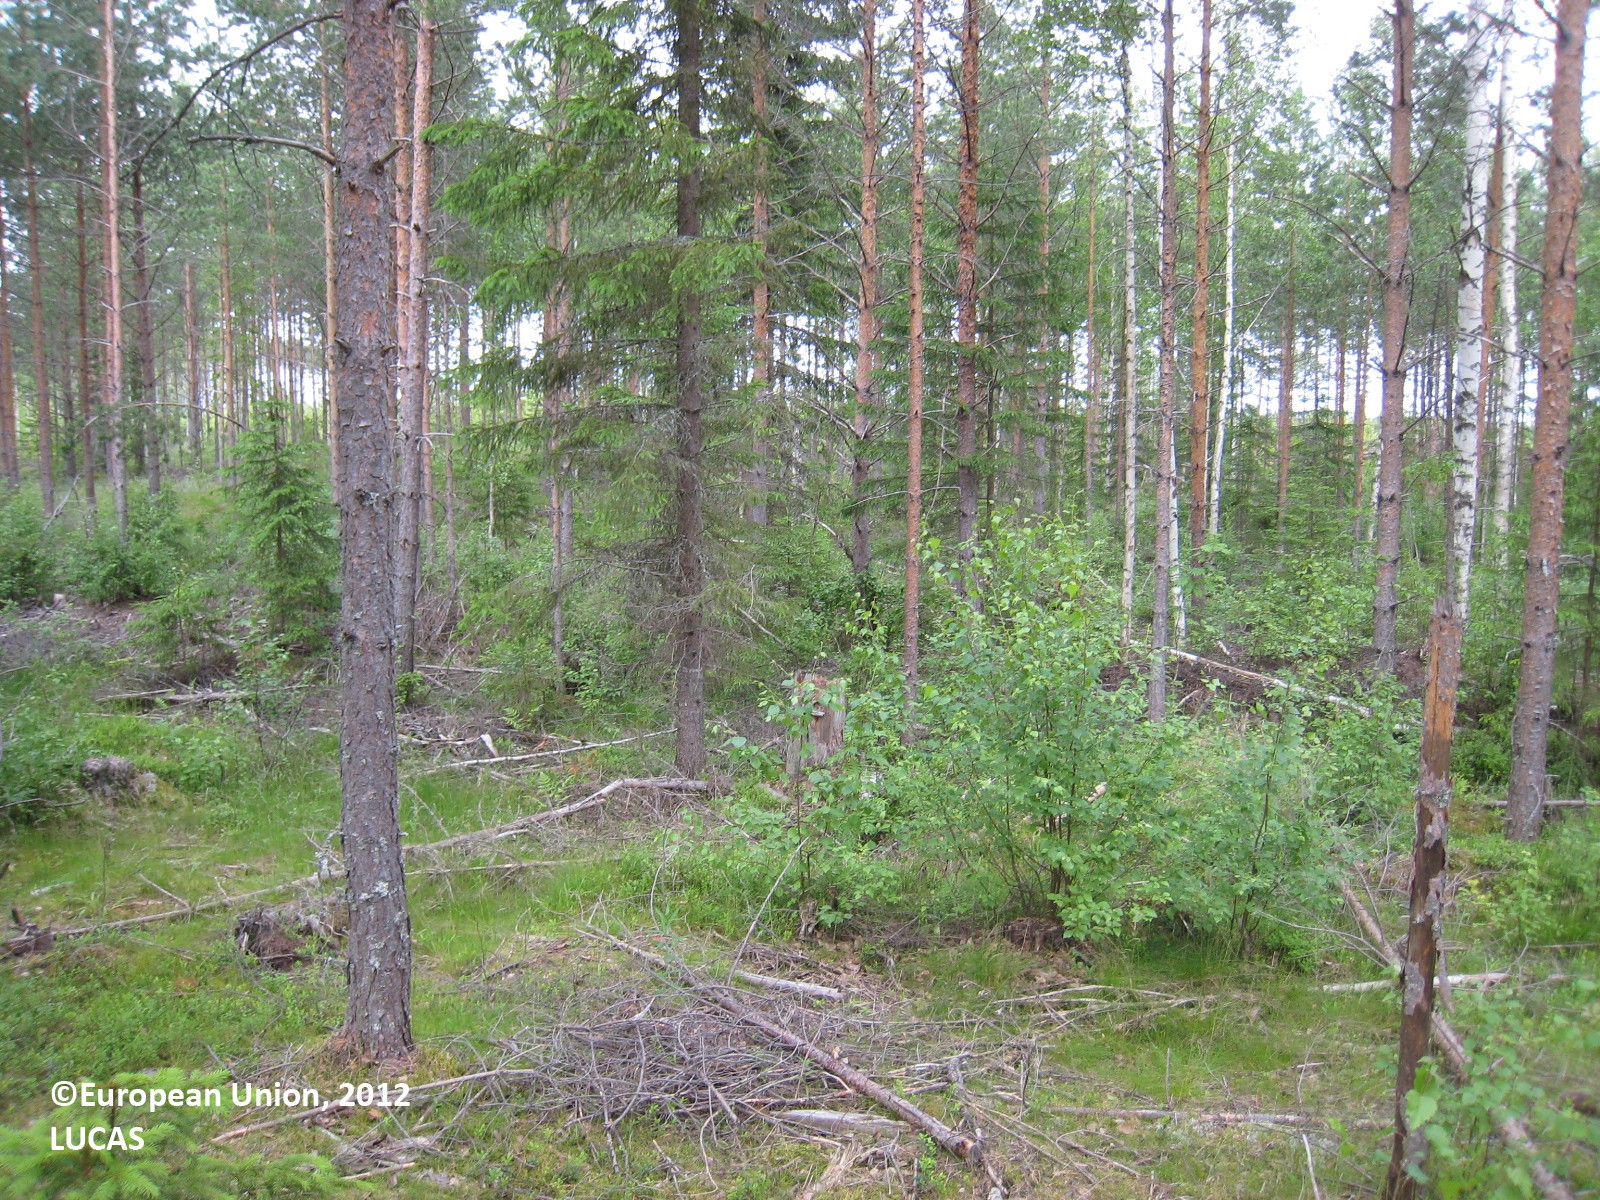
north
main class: Woodland
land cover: Pine dominated coniferous woodland
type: boreal forest
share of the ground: 50 - 75 %
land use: Forestry
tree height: > 5 m
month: June
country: FI
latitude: 62.1700
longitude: 26.3618
